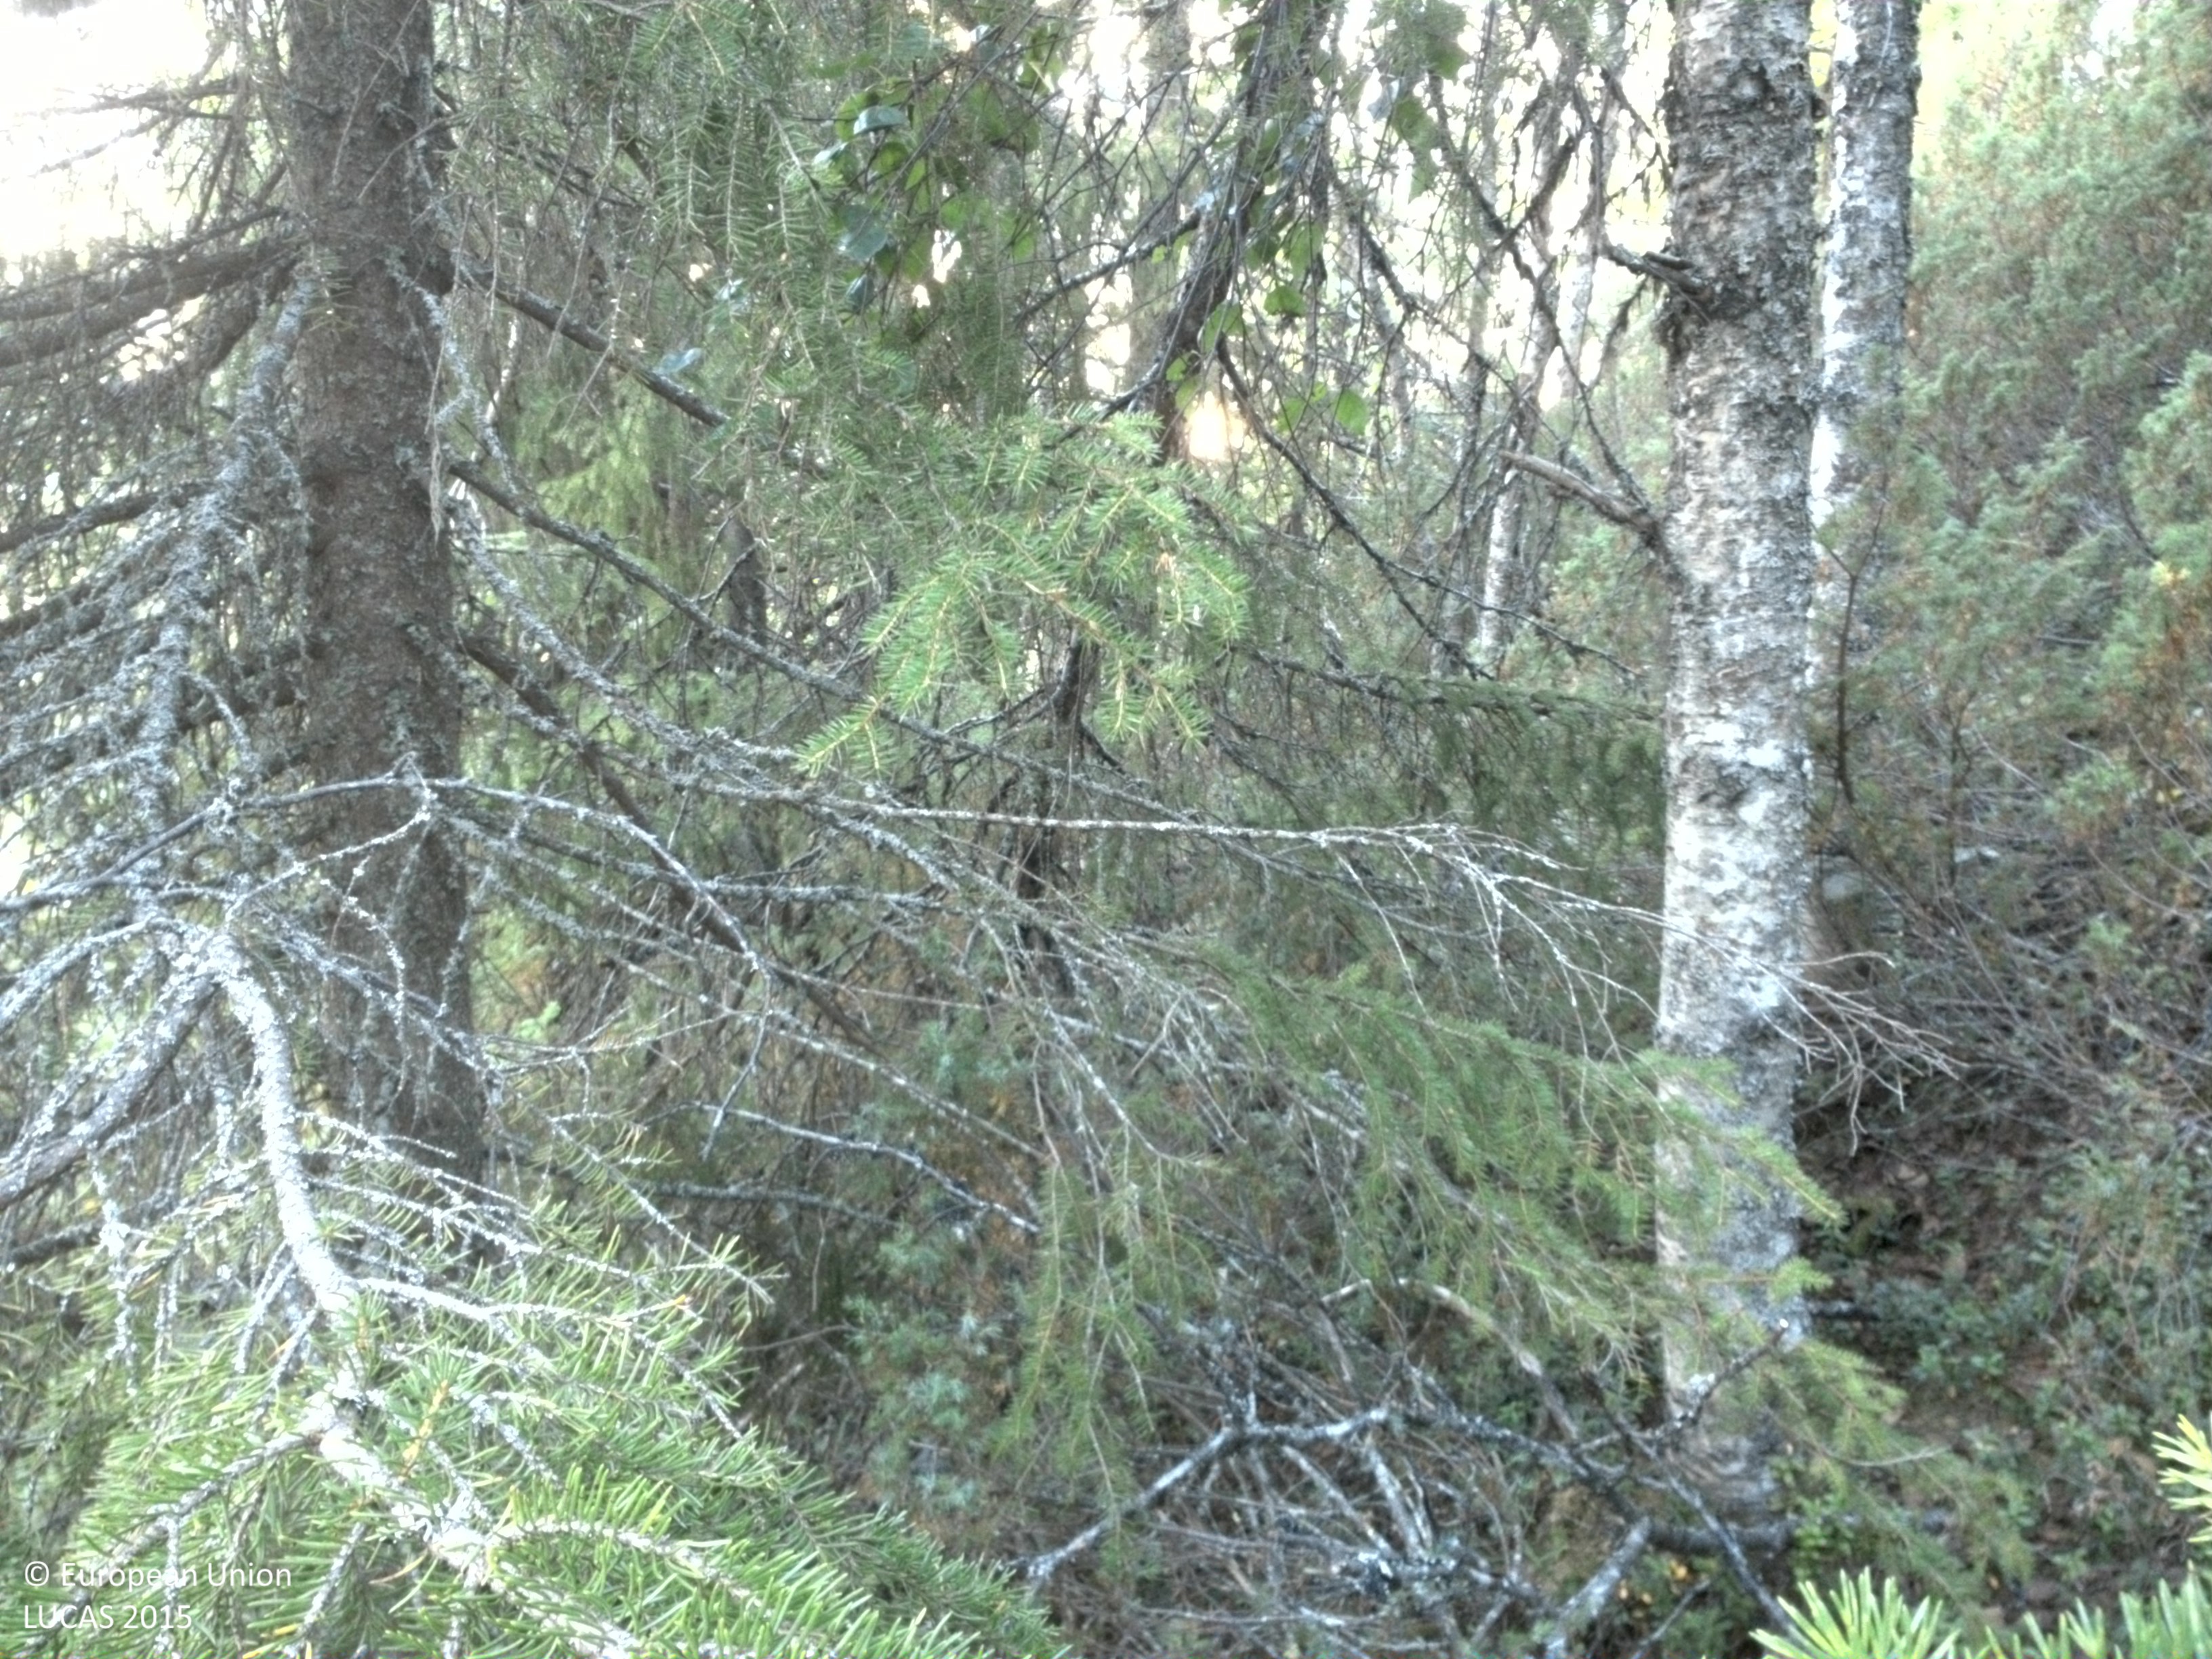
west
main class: Woodland
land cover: Spruce dominated mixed woodland
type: boreal forest
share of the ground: 25 - 50 %
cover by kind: shrubs 50 %, broadleaved forest trees 25 %, coniferous forest trees 20 %, lichens and mosses 5 %
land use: Forestry
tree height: > 5 m
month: September
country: SE
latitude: 64.9716
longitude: 16.5108
